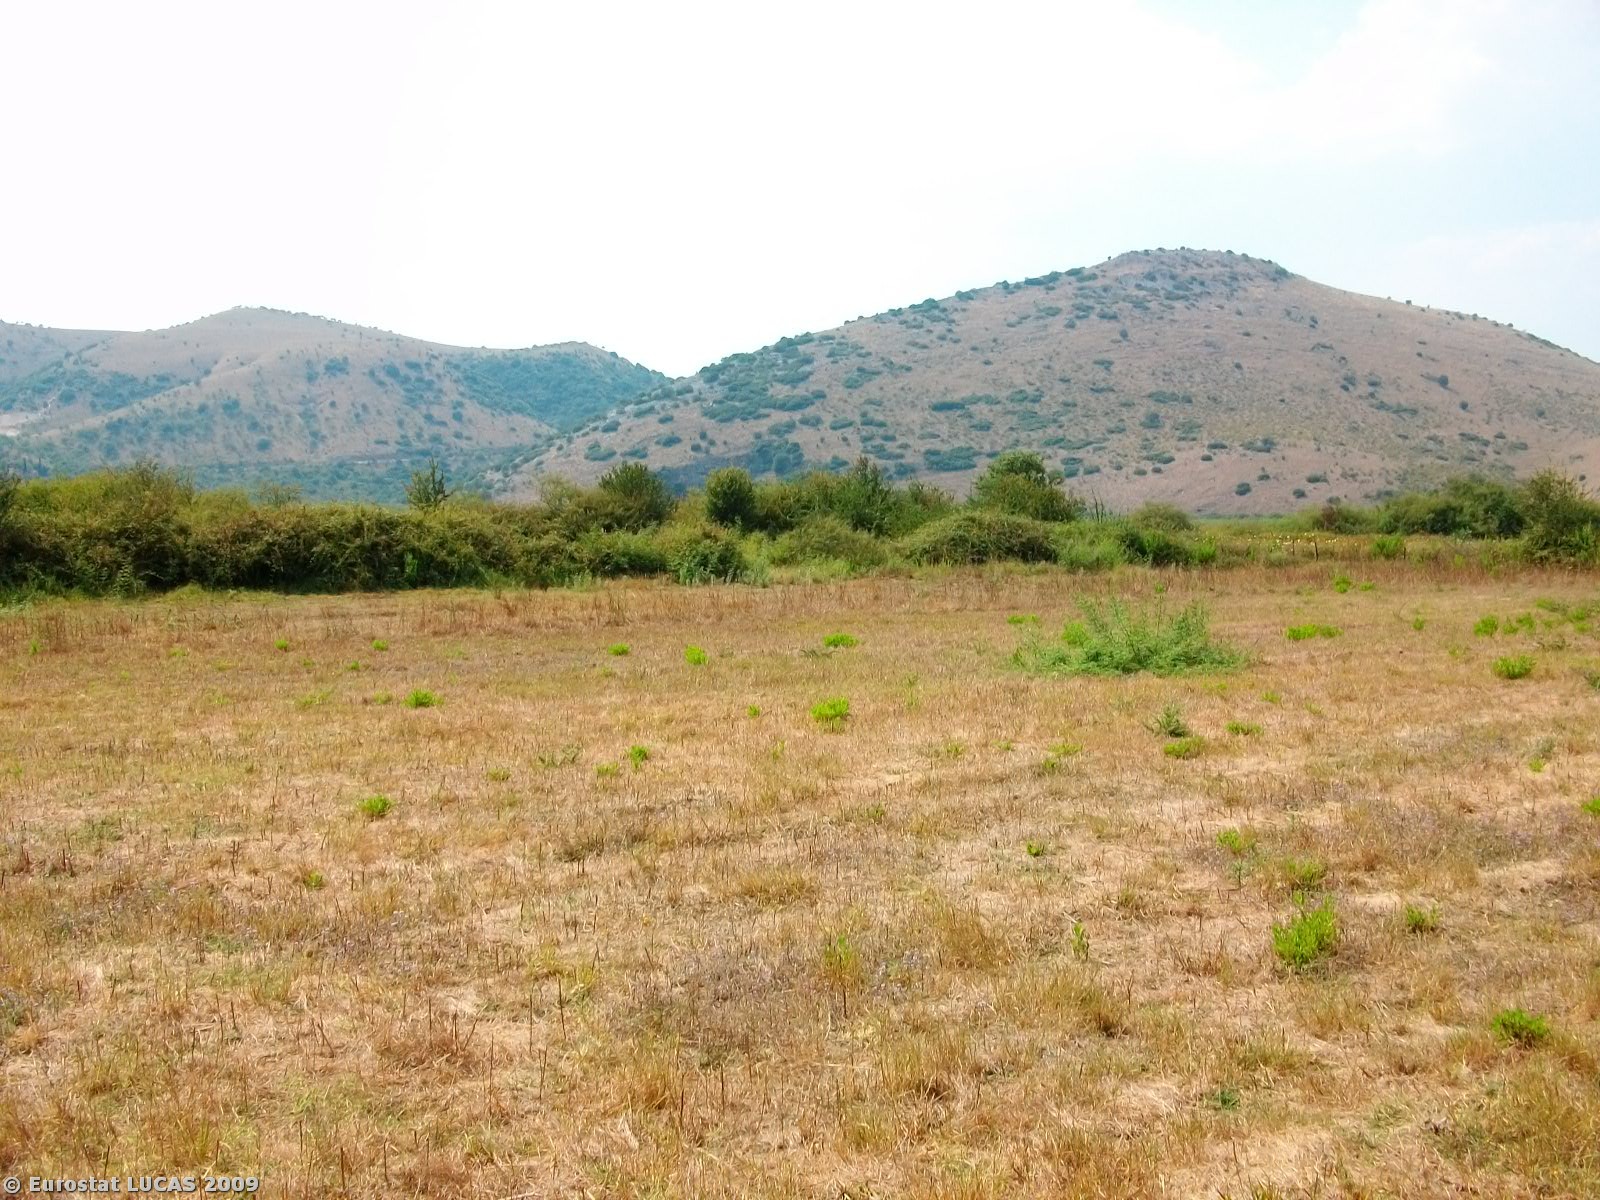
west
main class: Grassland
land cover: Grassland with sparse tree/shrub cover
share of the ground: > 75 %
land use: Agriculture (excluding fallow land and kitchen gardens)
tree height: < 5 m
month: August
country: GR
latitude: 39.3837
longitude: 20.4104
